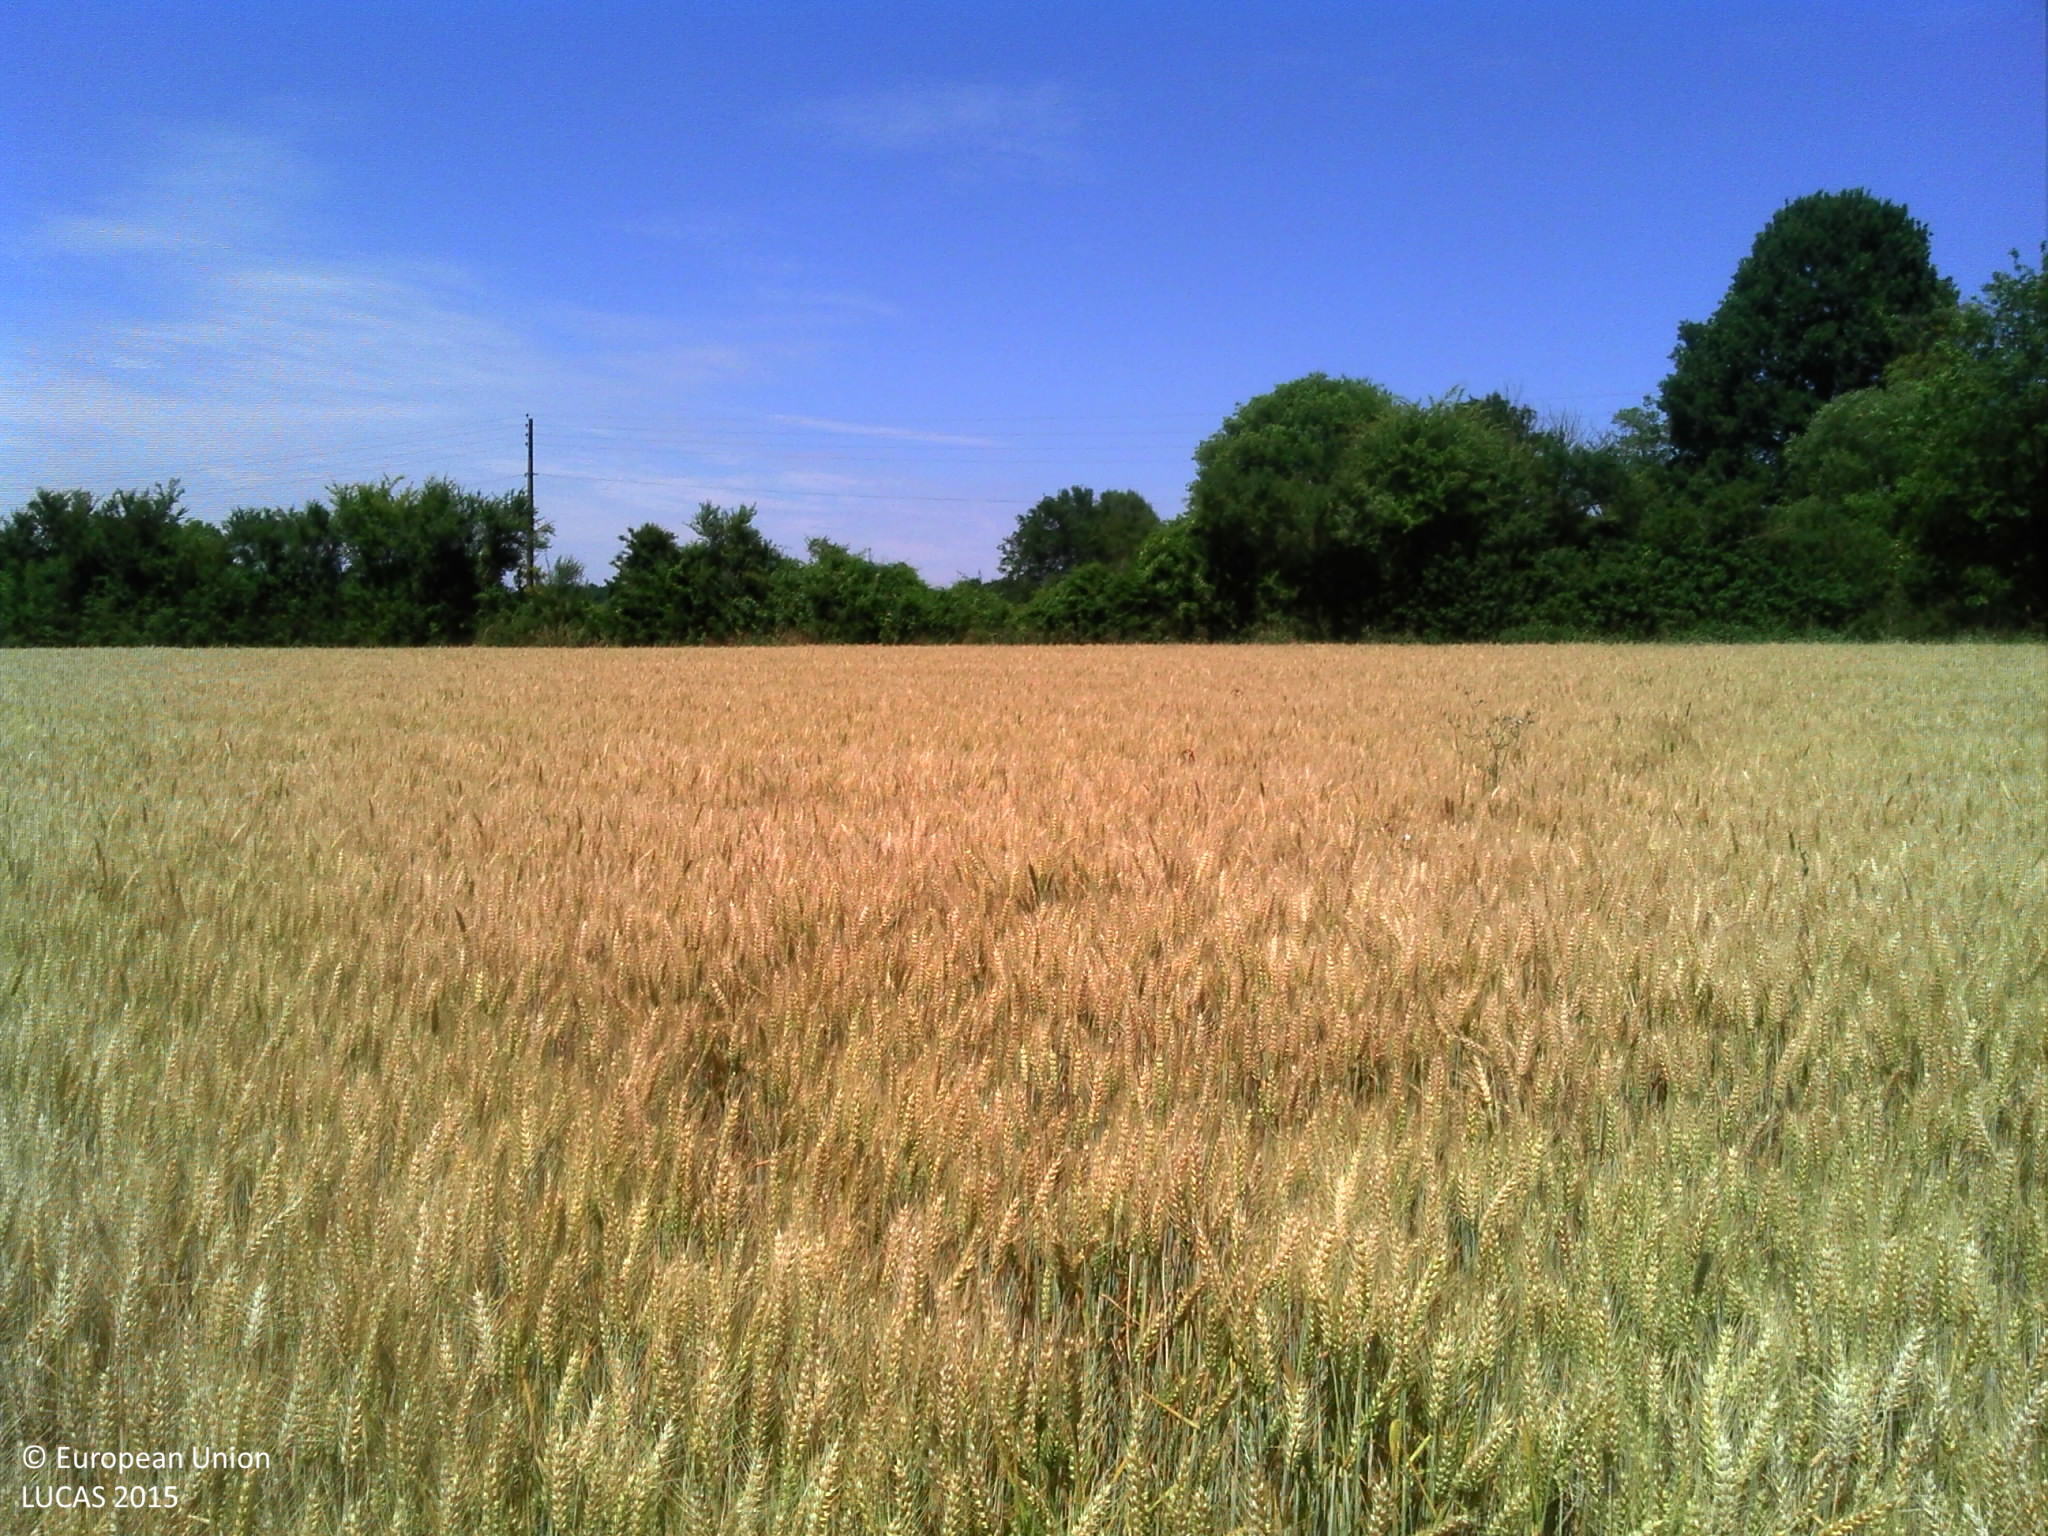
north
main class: Cropland
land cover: Durum wheat
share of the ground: > 75 %
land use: Agriculture (excluding fallow land and kitchen gardens)
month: June
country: FR
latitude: 47.5023
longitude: 0.2719
